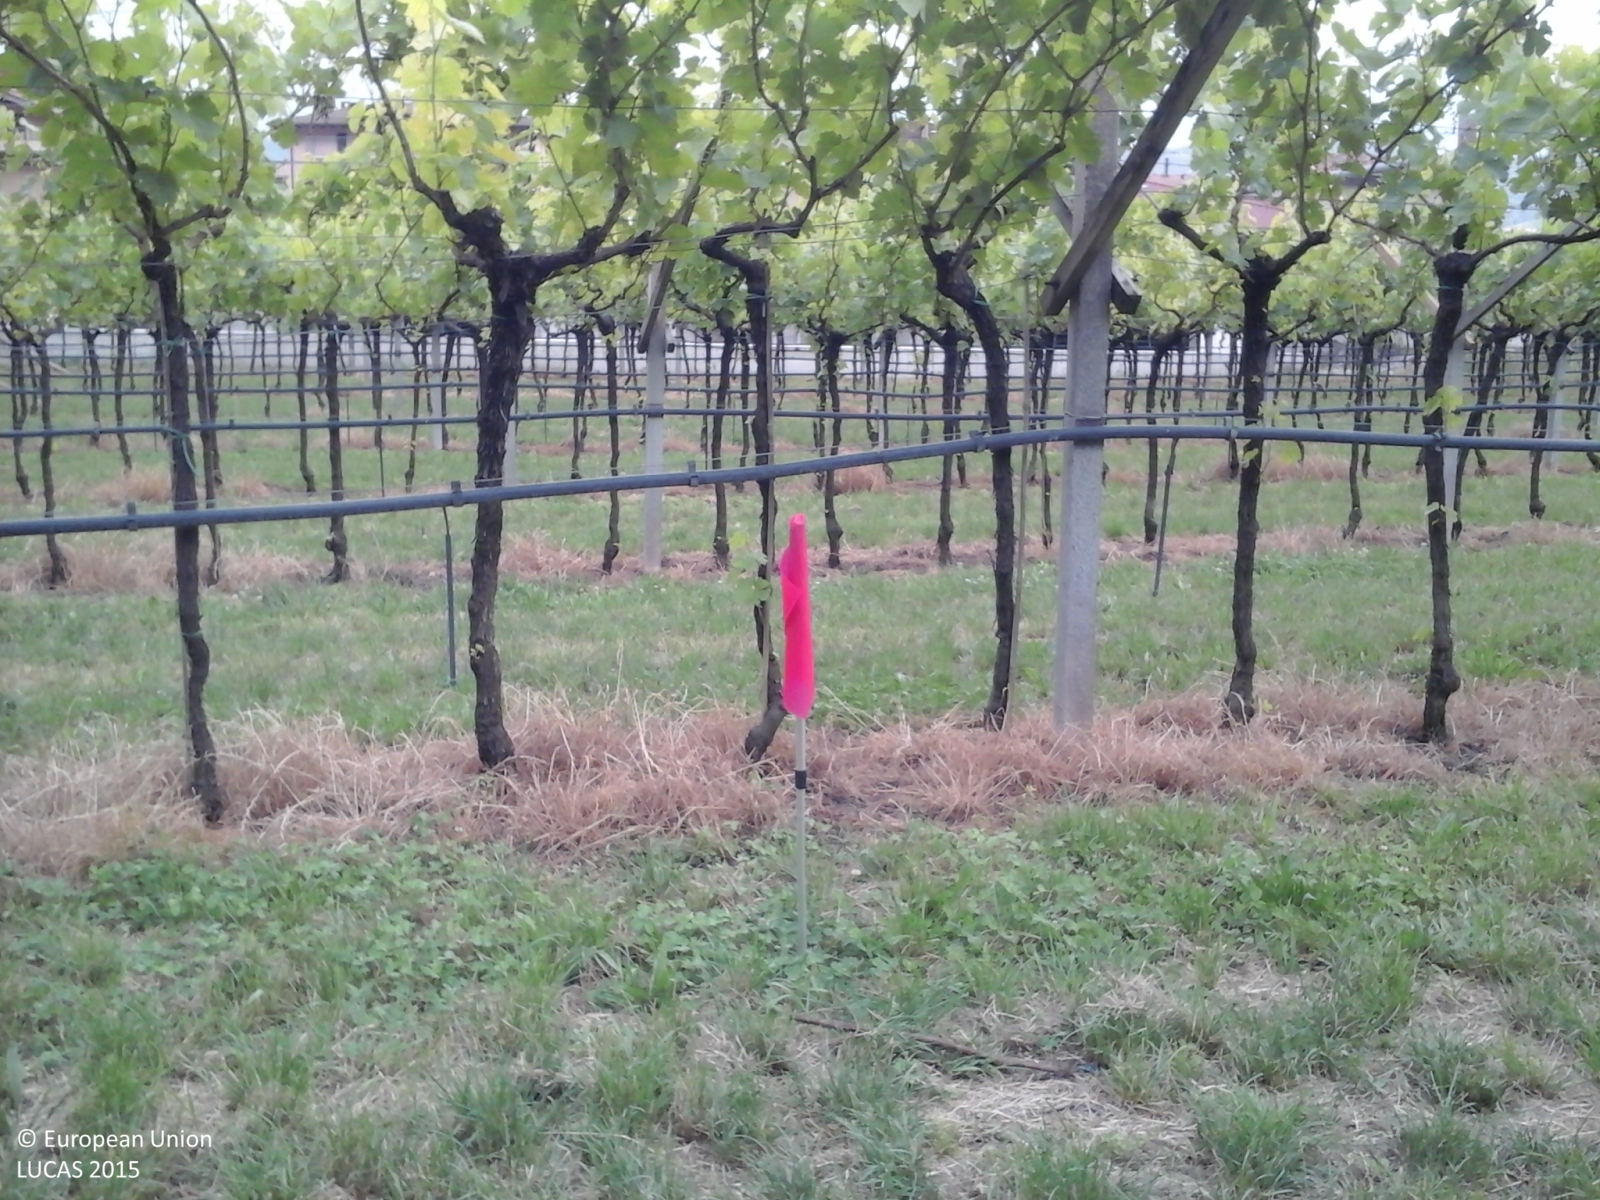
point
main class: Cropland
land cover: Vineyards
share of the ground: 10 - 25 %
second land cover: Grassland without tree/shrub cover
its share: > 75 %
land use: Agriculture (excluding fallow land and kitchen gardens)
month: June
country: IT
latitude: 46.0228
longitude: 10.9416
